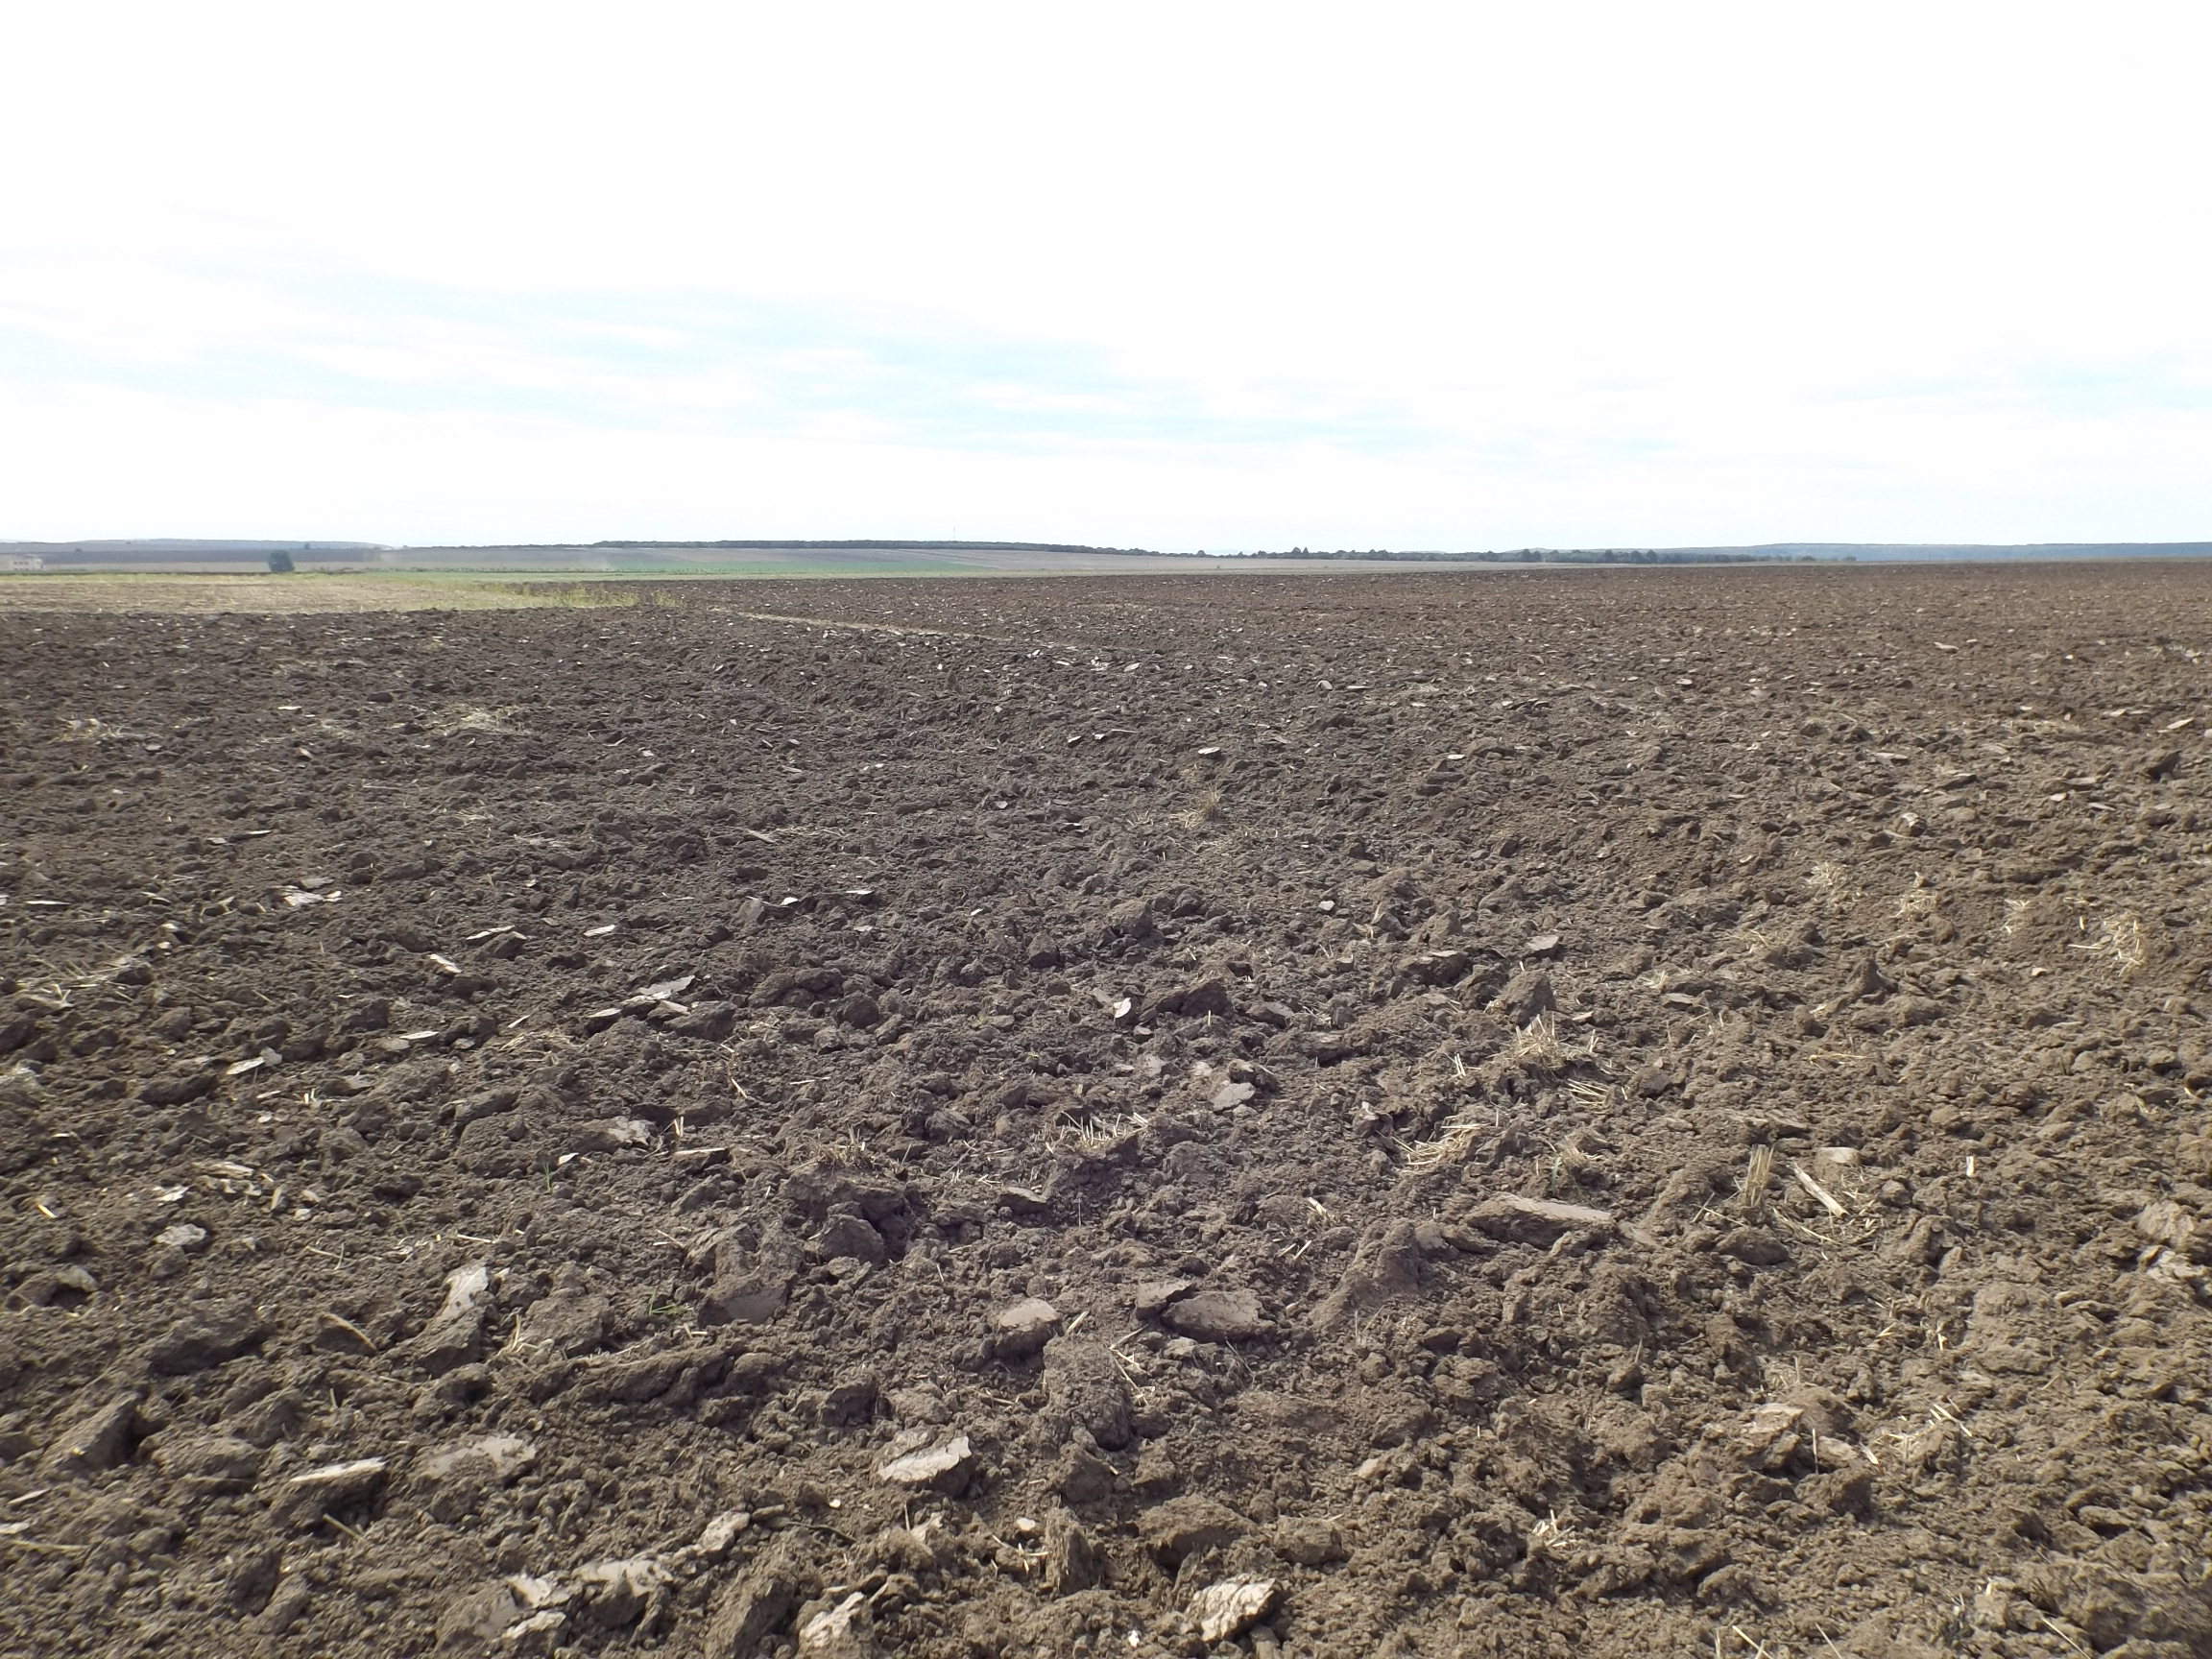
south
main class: Cropland
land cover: Common wheat
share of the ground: < 10 %
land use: Agriculture (excluding fallow land and kitchen gardens)
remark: Harvested field
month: September
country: BG
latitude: 43.4090
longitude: 27.3526
